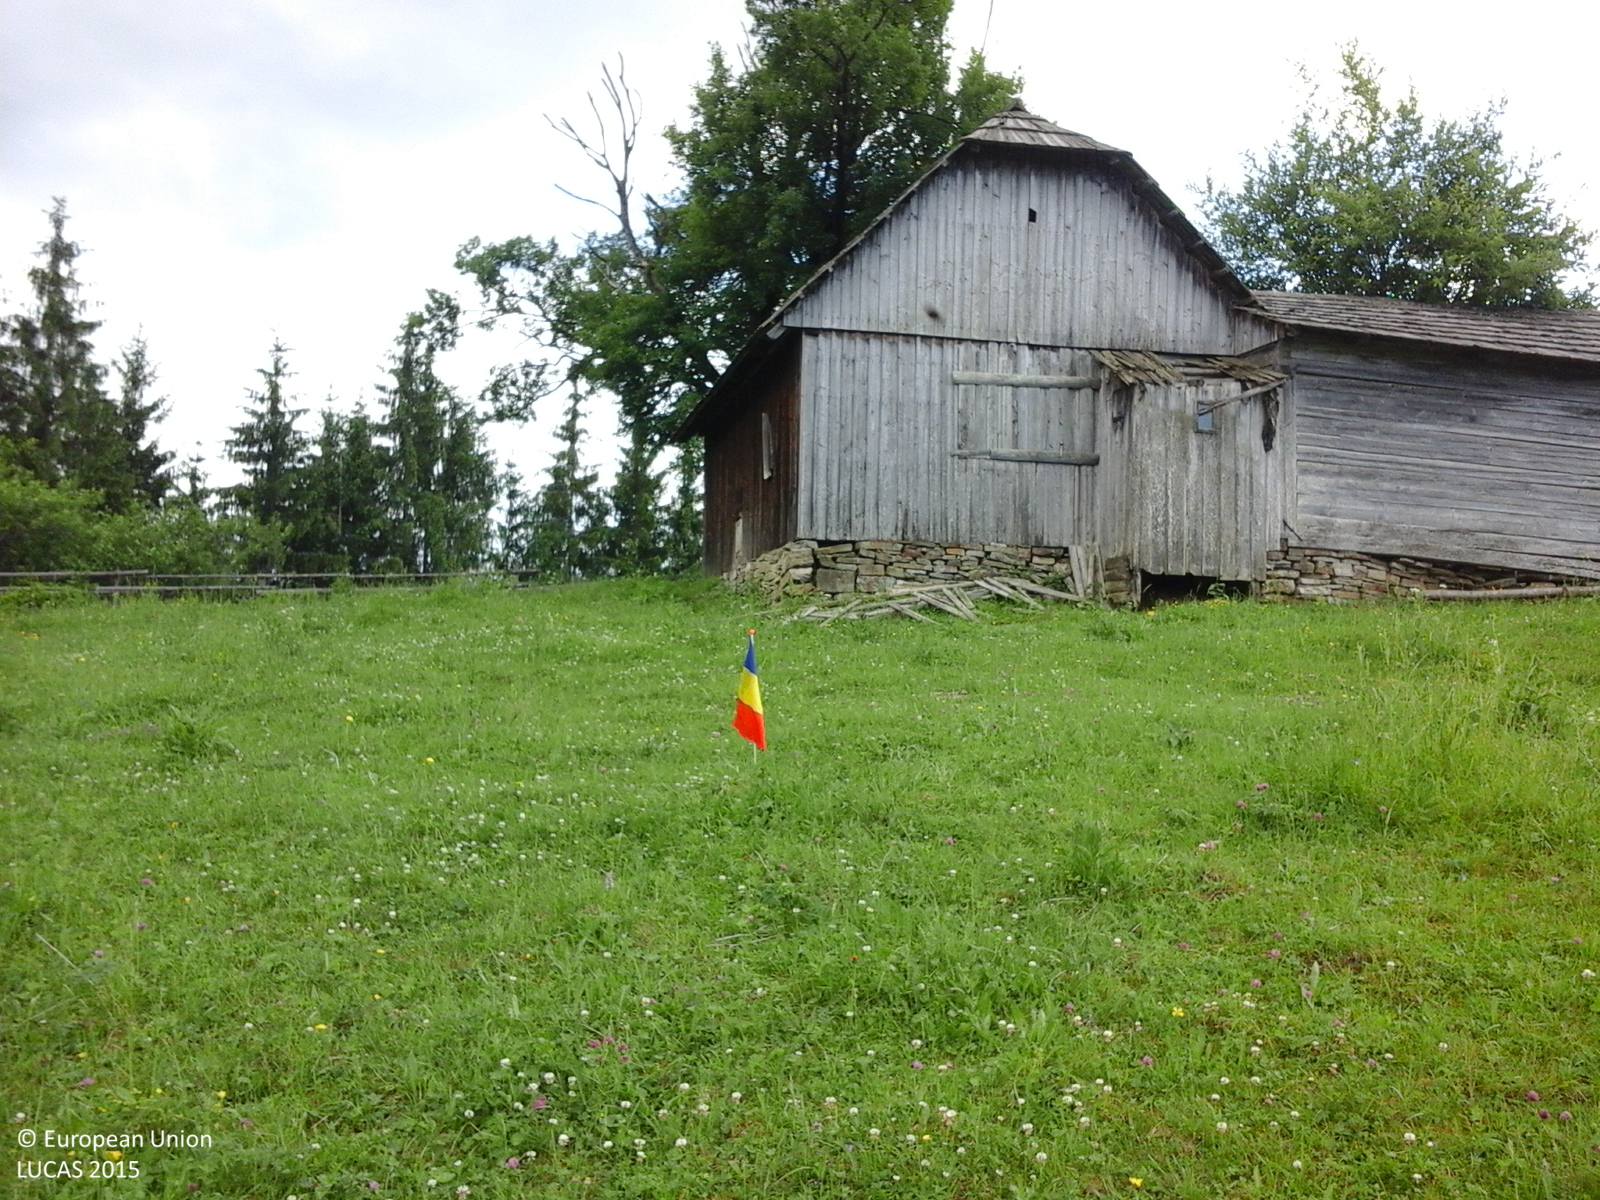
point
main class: Grassland
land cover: Grassland without tree/shrub cover
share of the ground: > 75 %
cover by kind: herbaceous plants 100 %
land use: Agriculture (excluding fallow land and kitchen gardens)
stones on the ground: < 10 %
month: June
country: RO
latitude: 47.8497
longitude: 25.2539
